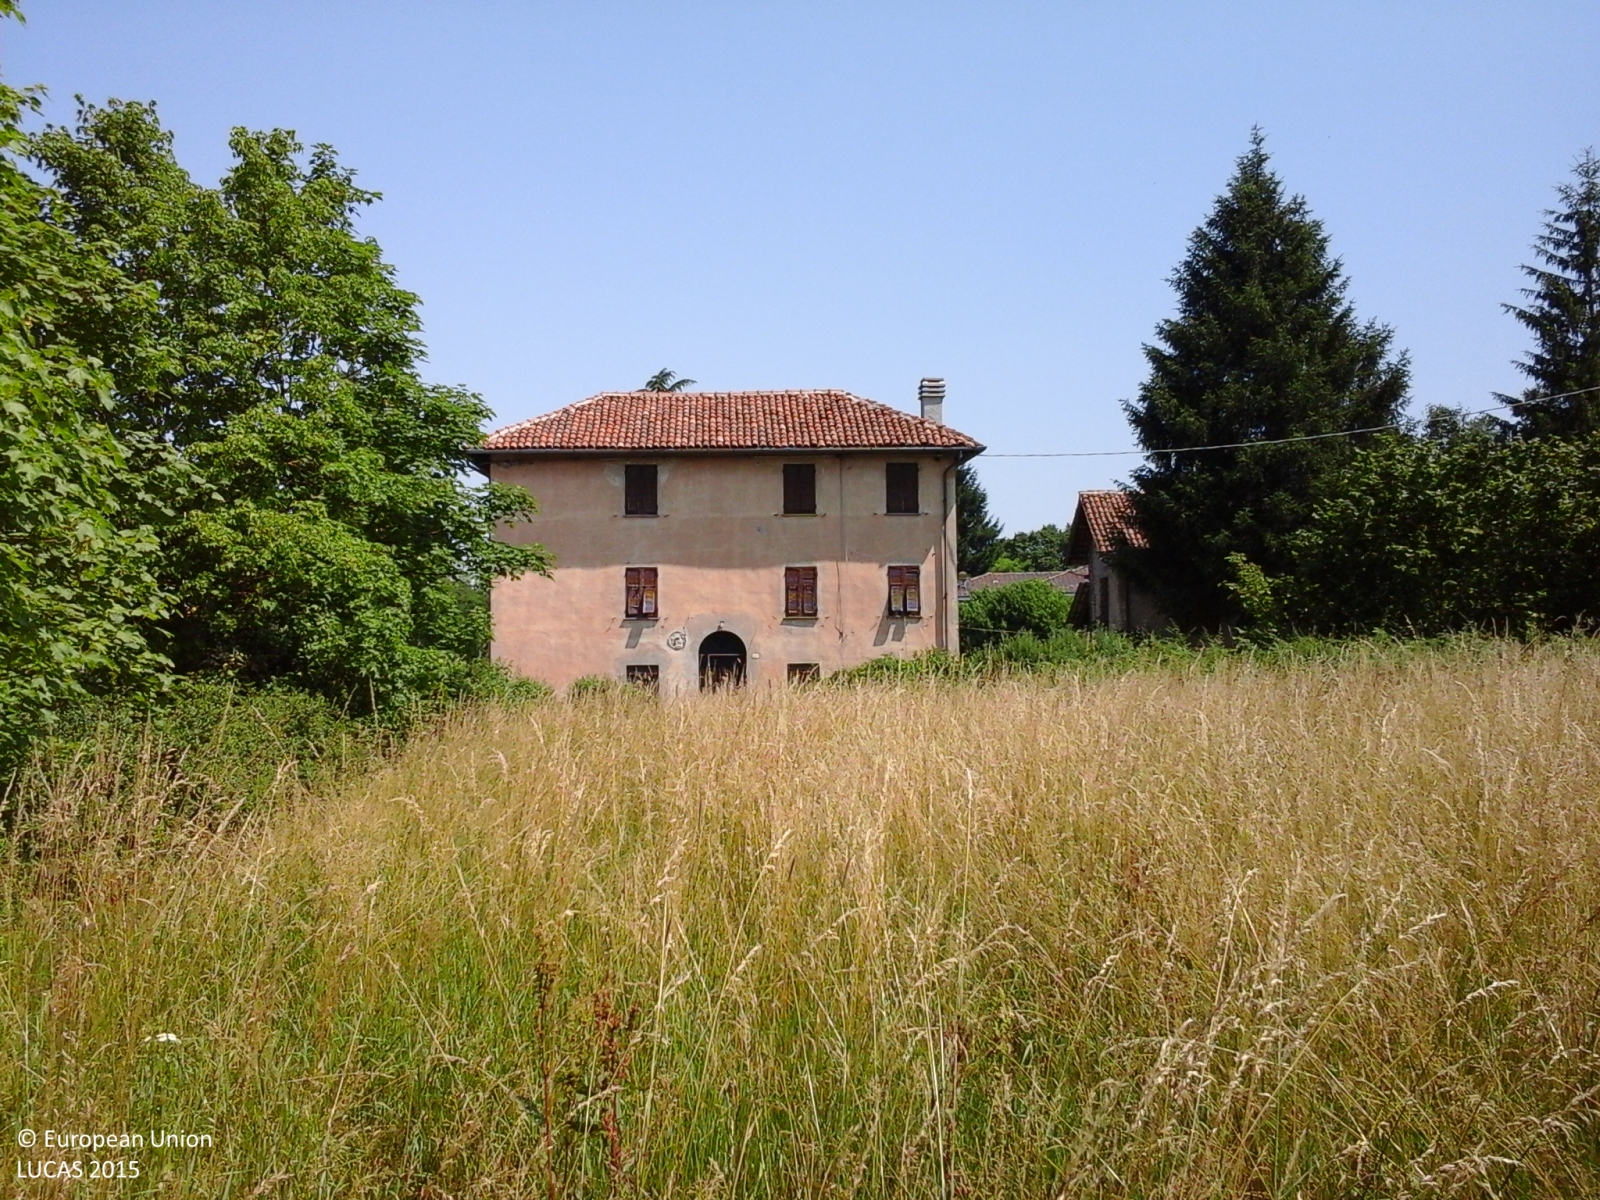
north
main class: Grassland
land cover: Grassland without tree/shrub cover
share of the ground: > 75 %
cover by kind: herbaceous plants 100 %
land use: Agriculture (excluding fallow land and kitchen gardens)
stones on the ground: 10 - 25 %
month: June
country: IT
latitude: 44.6484
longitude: 8.6537
